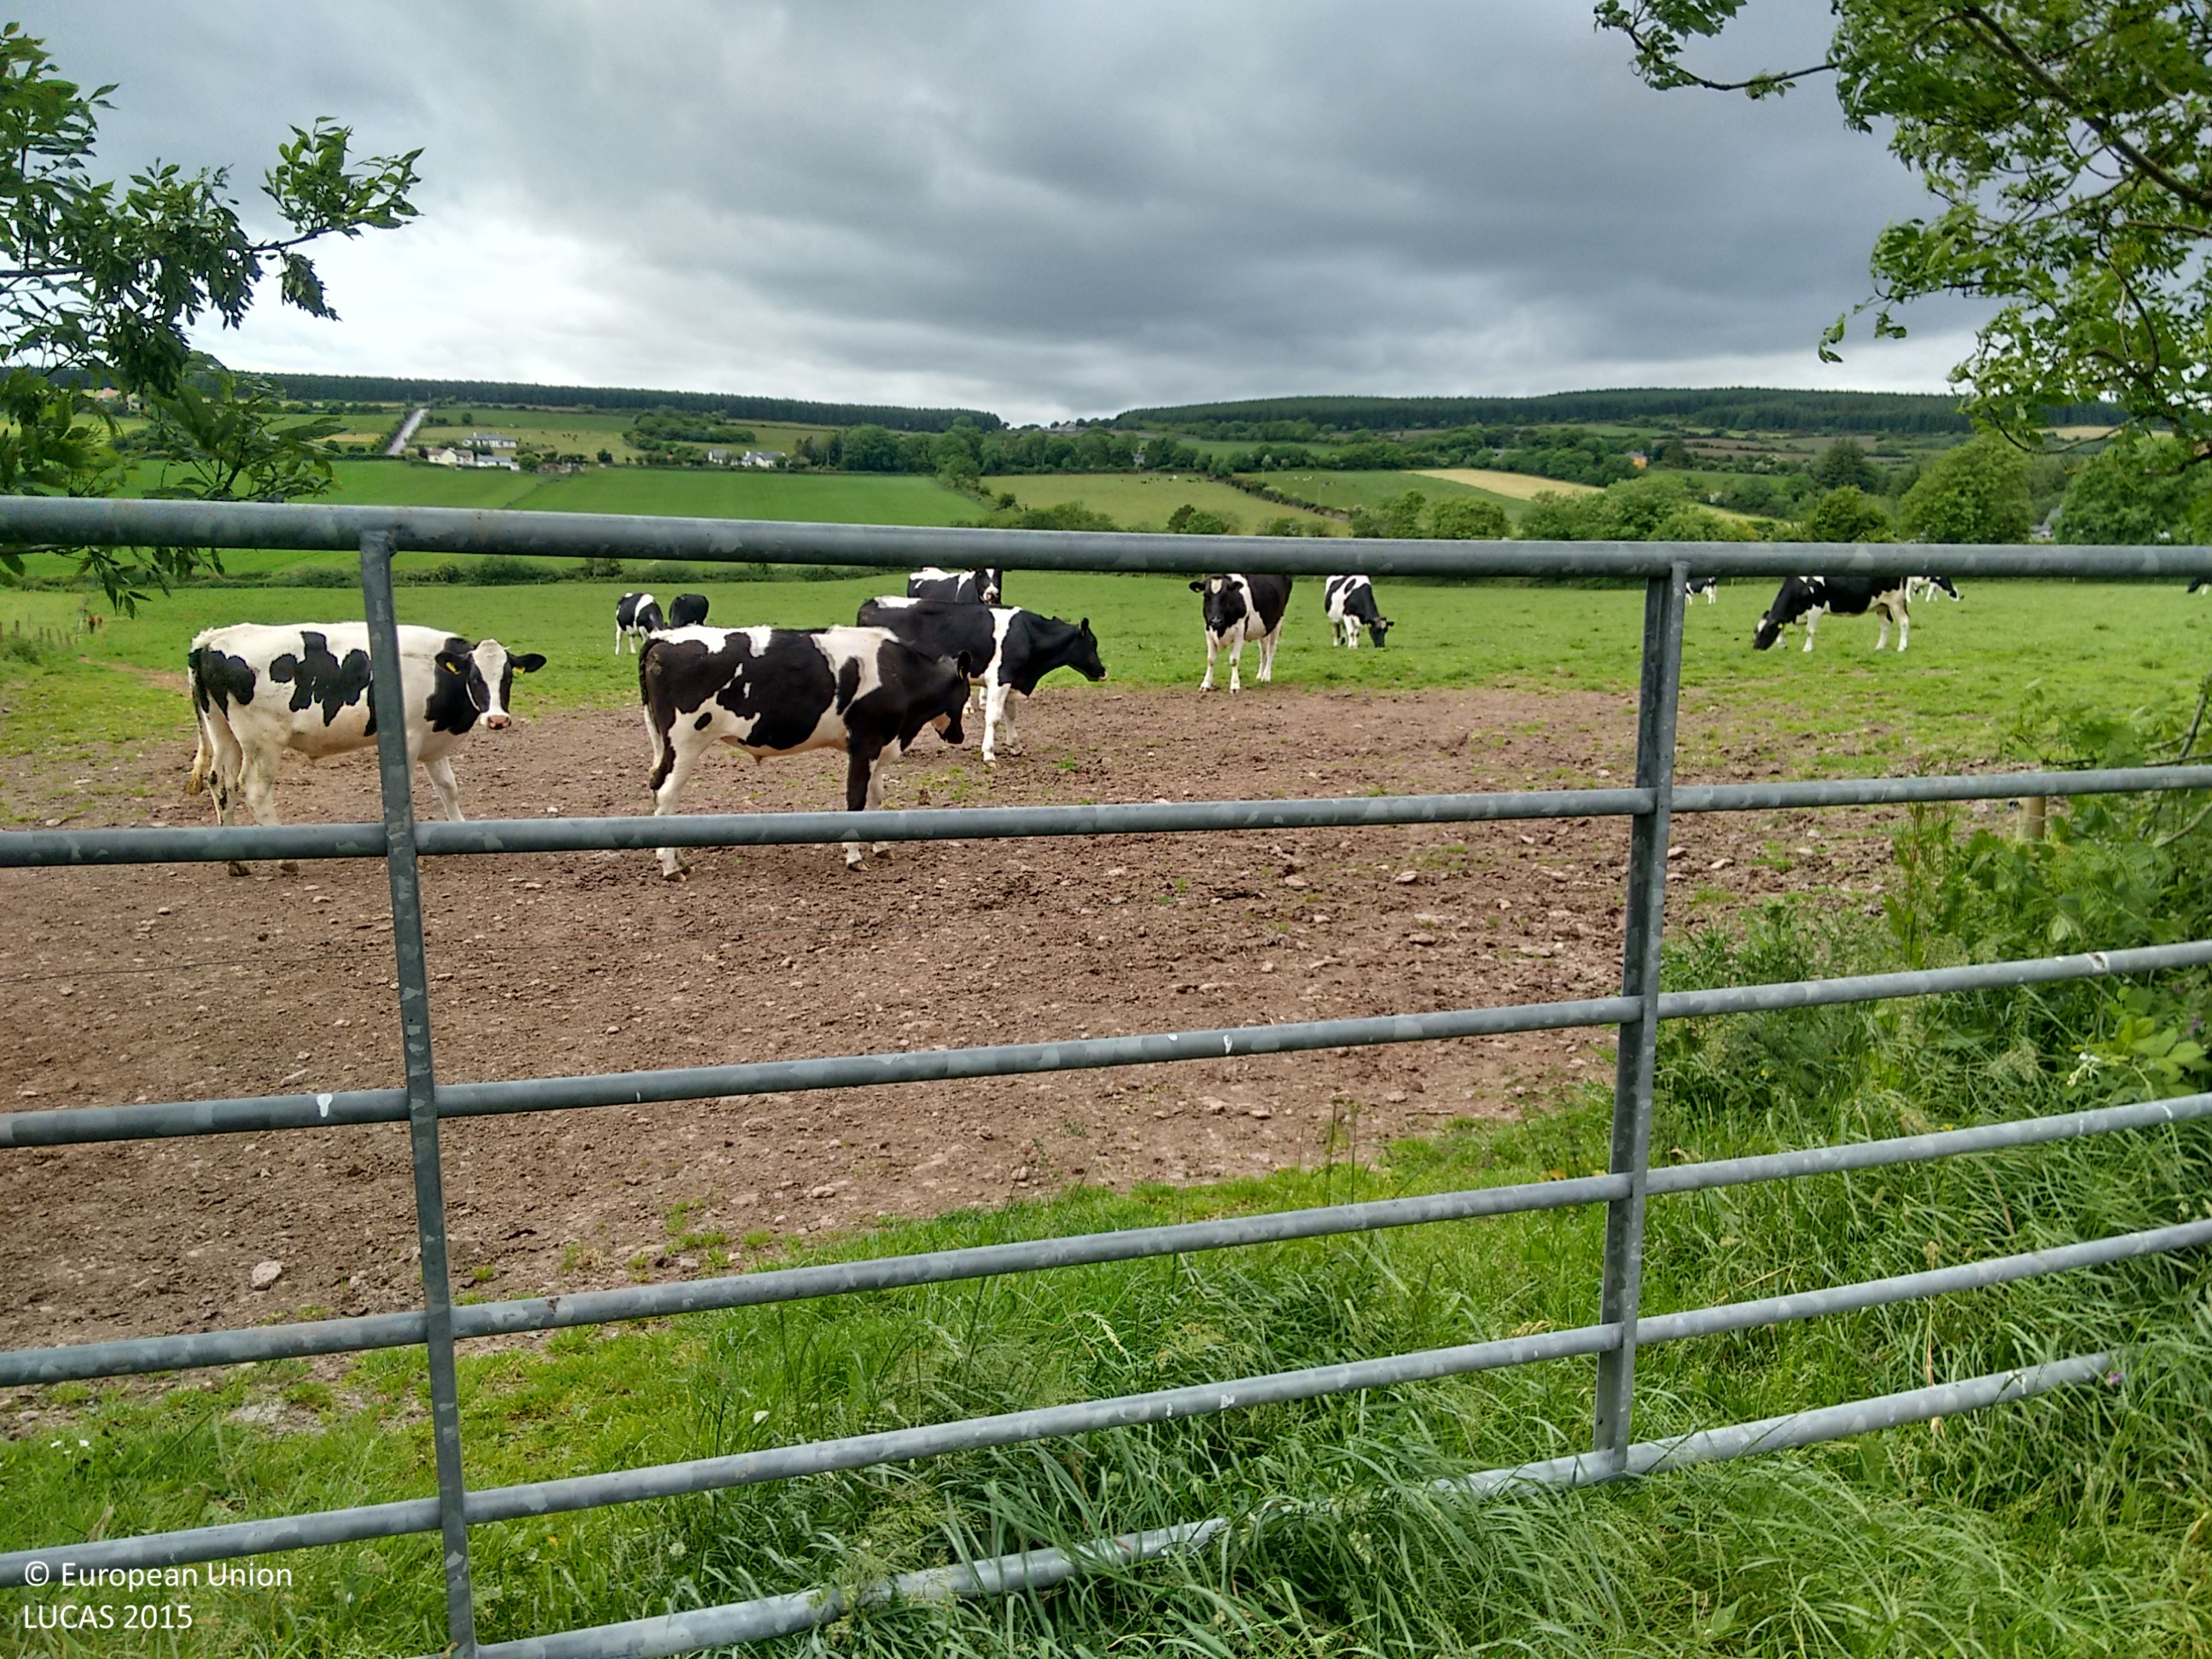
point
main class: Grassland
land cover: Grassland without tree/shrub cover
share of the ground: > 75 %
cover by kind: herbaceous plants 100 %
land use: Agriculture (excluding fallow land and kitchen gardens)
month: June
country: IE
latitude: 52.0004
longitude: -8.1107
